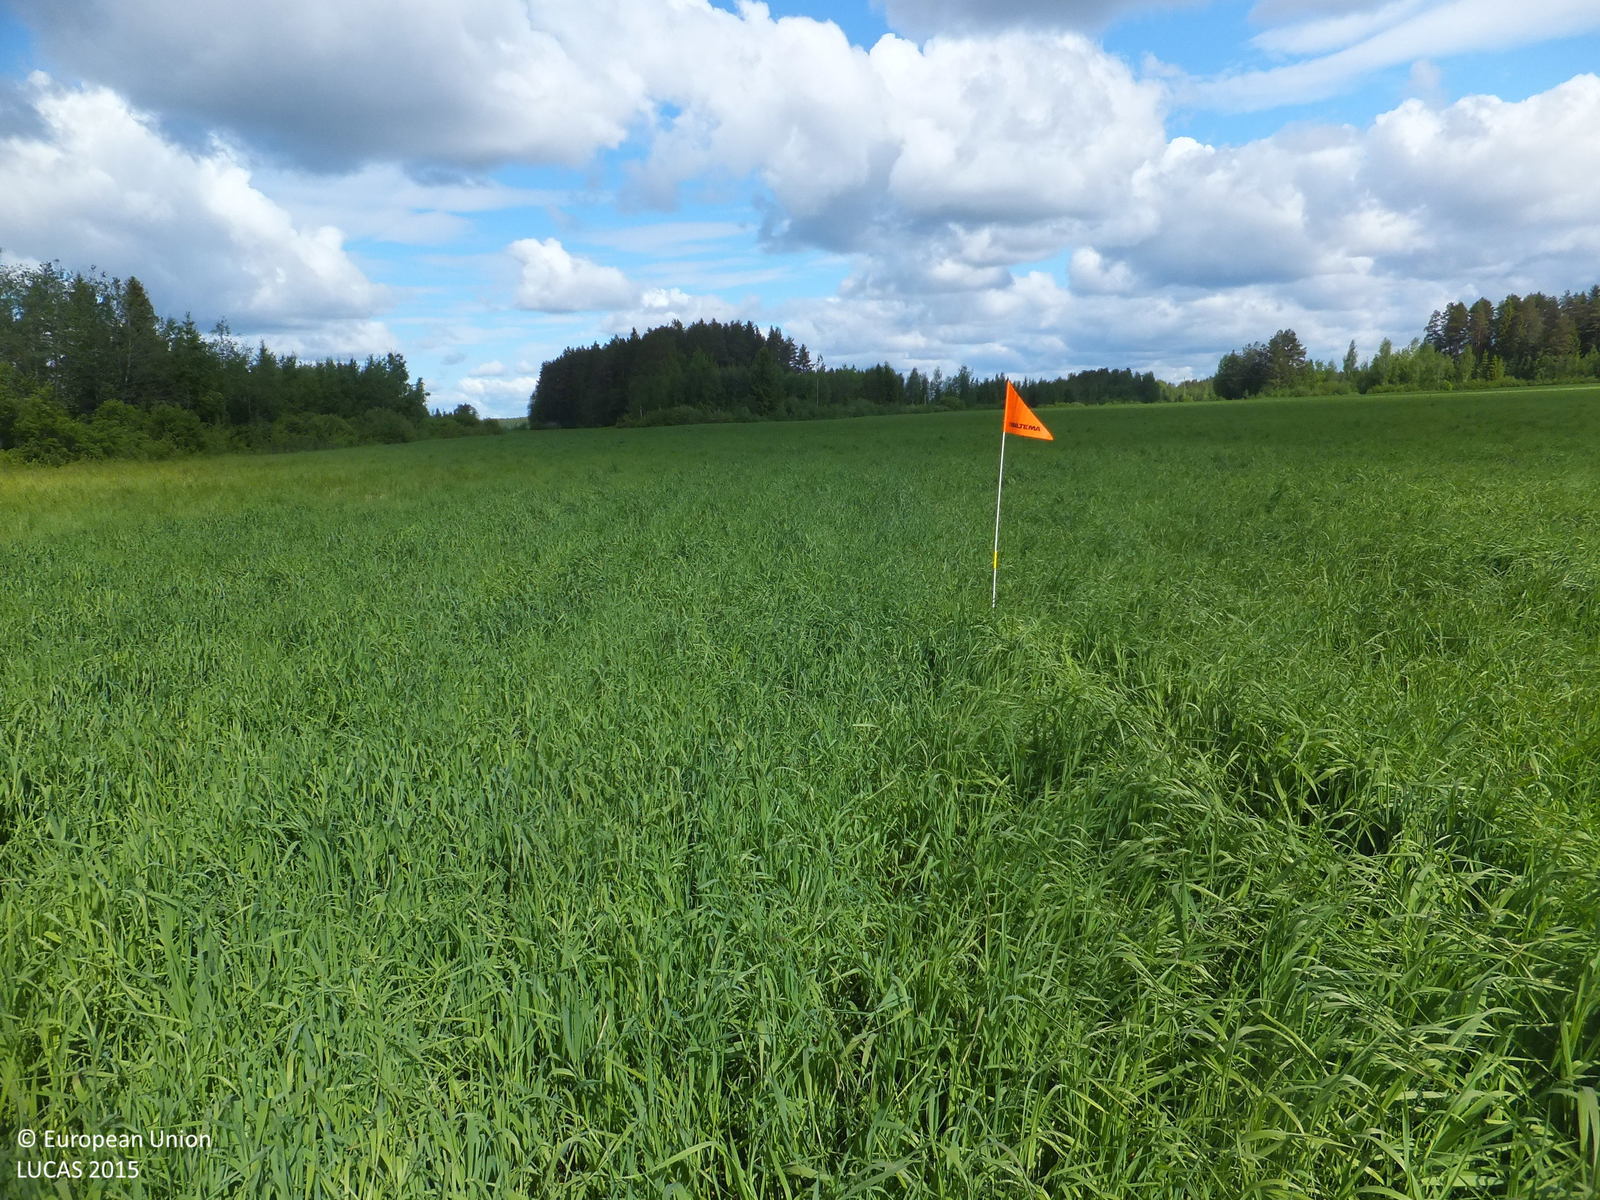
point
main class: Cropland
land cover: Temporary grasslands
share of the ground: > 75 %
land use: Agriculture (excluding fallow land and kitchen gardens)
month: June
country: FI
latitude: 63.5341
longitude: 24.7871
